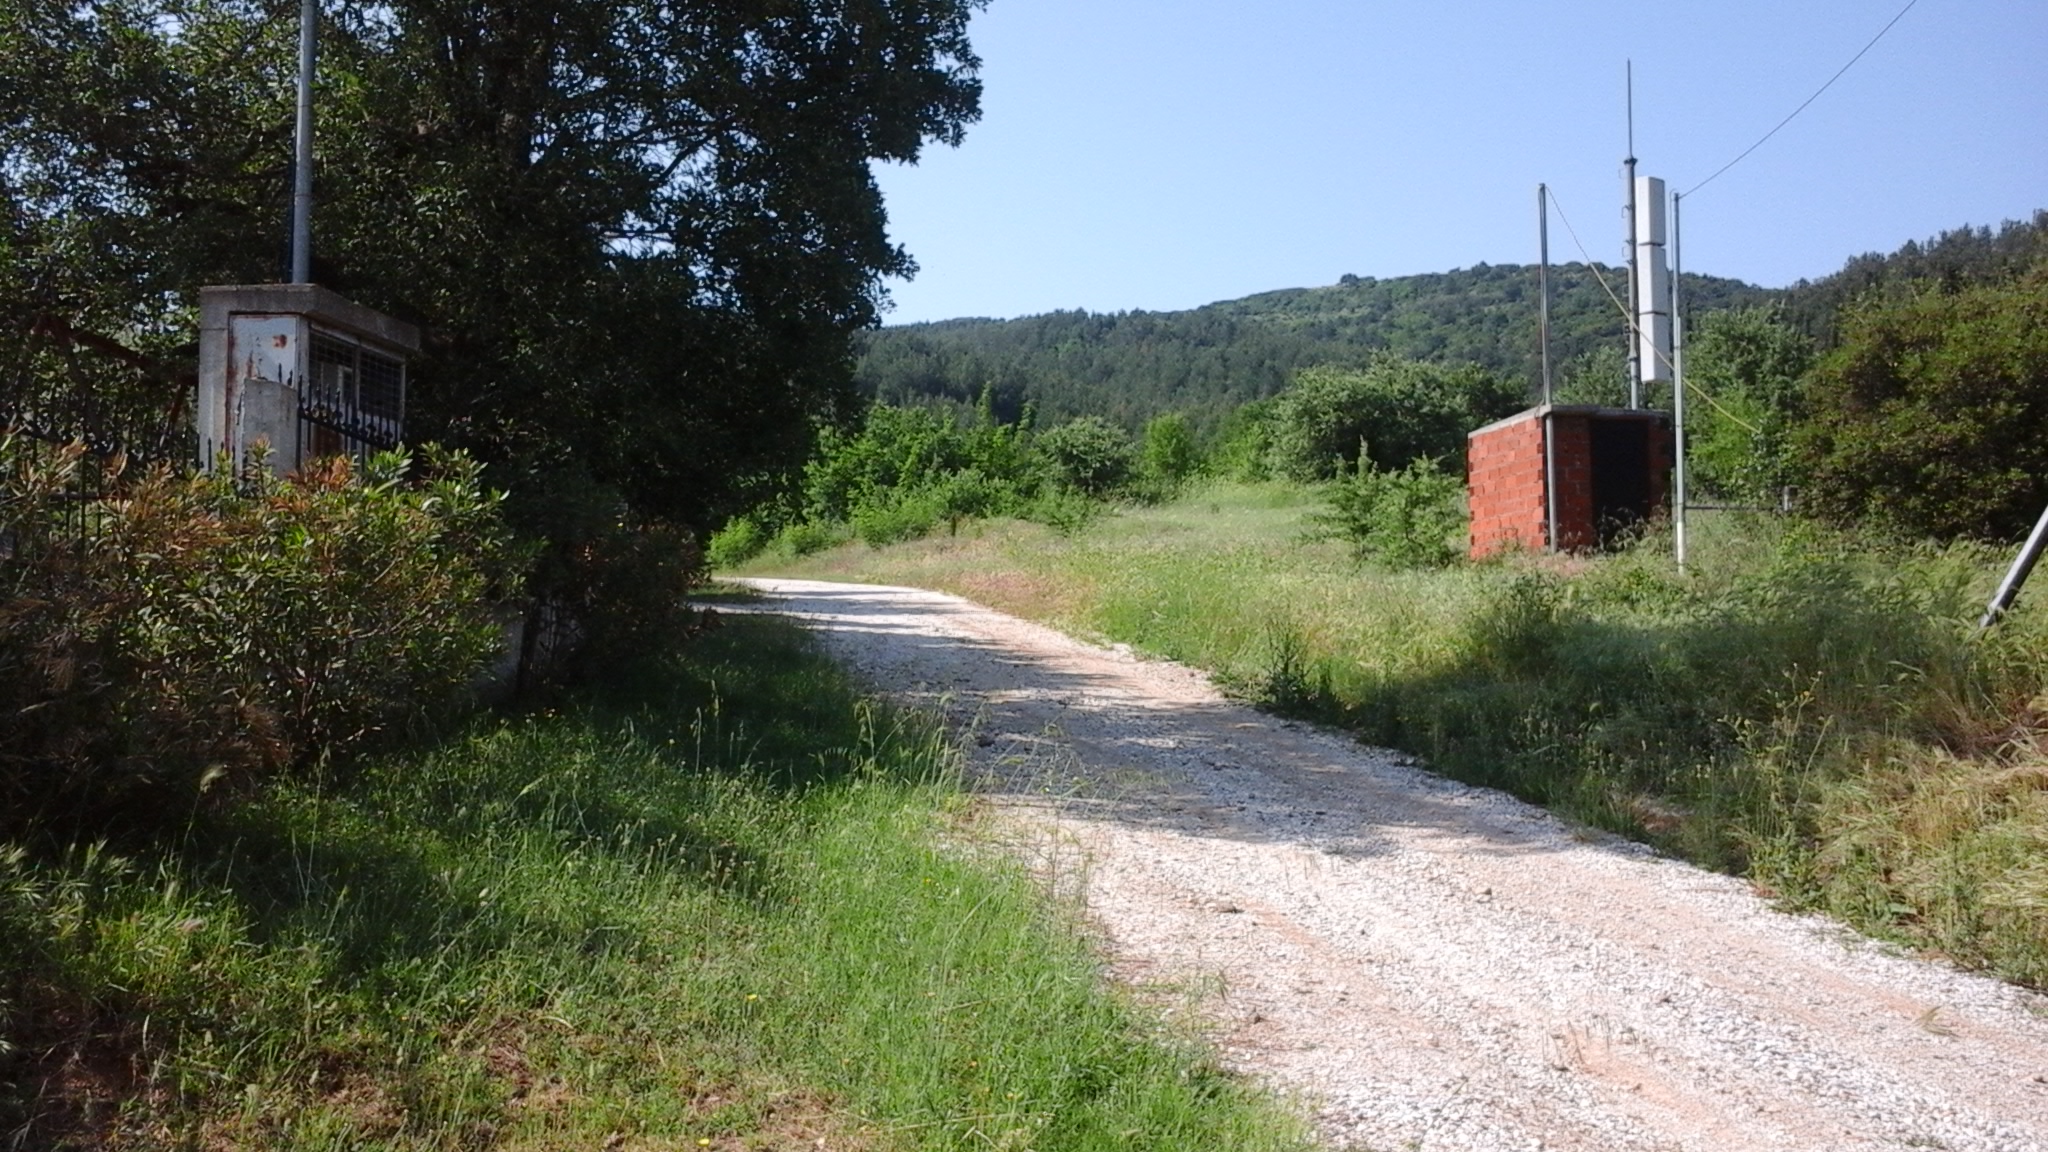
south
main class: Cropland
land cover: Nuts trees
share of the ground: 50 - 75 %
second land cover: Spontaneously vegetated surfaces
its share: > 75 %
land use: Agriculture (excluding fallow land and kitchen gardens)
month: May
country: GR
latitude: 40.7611
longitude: 22.9323
